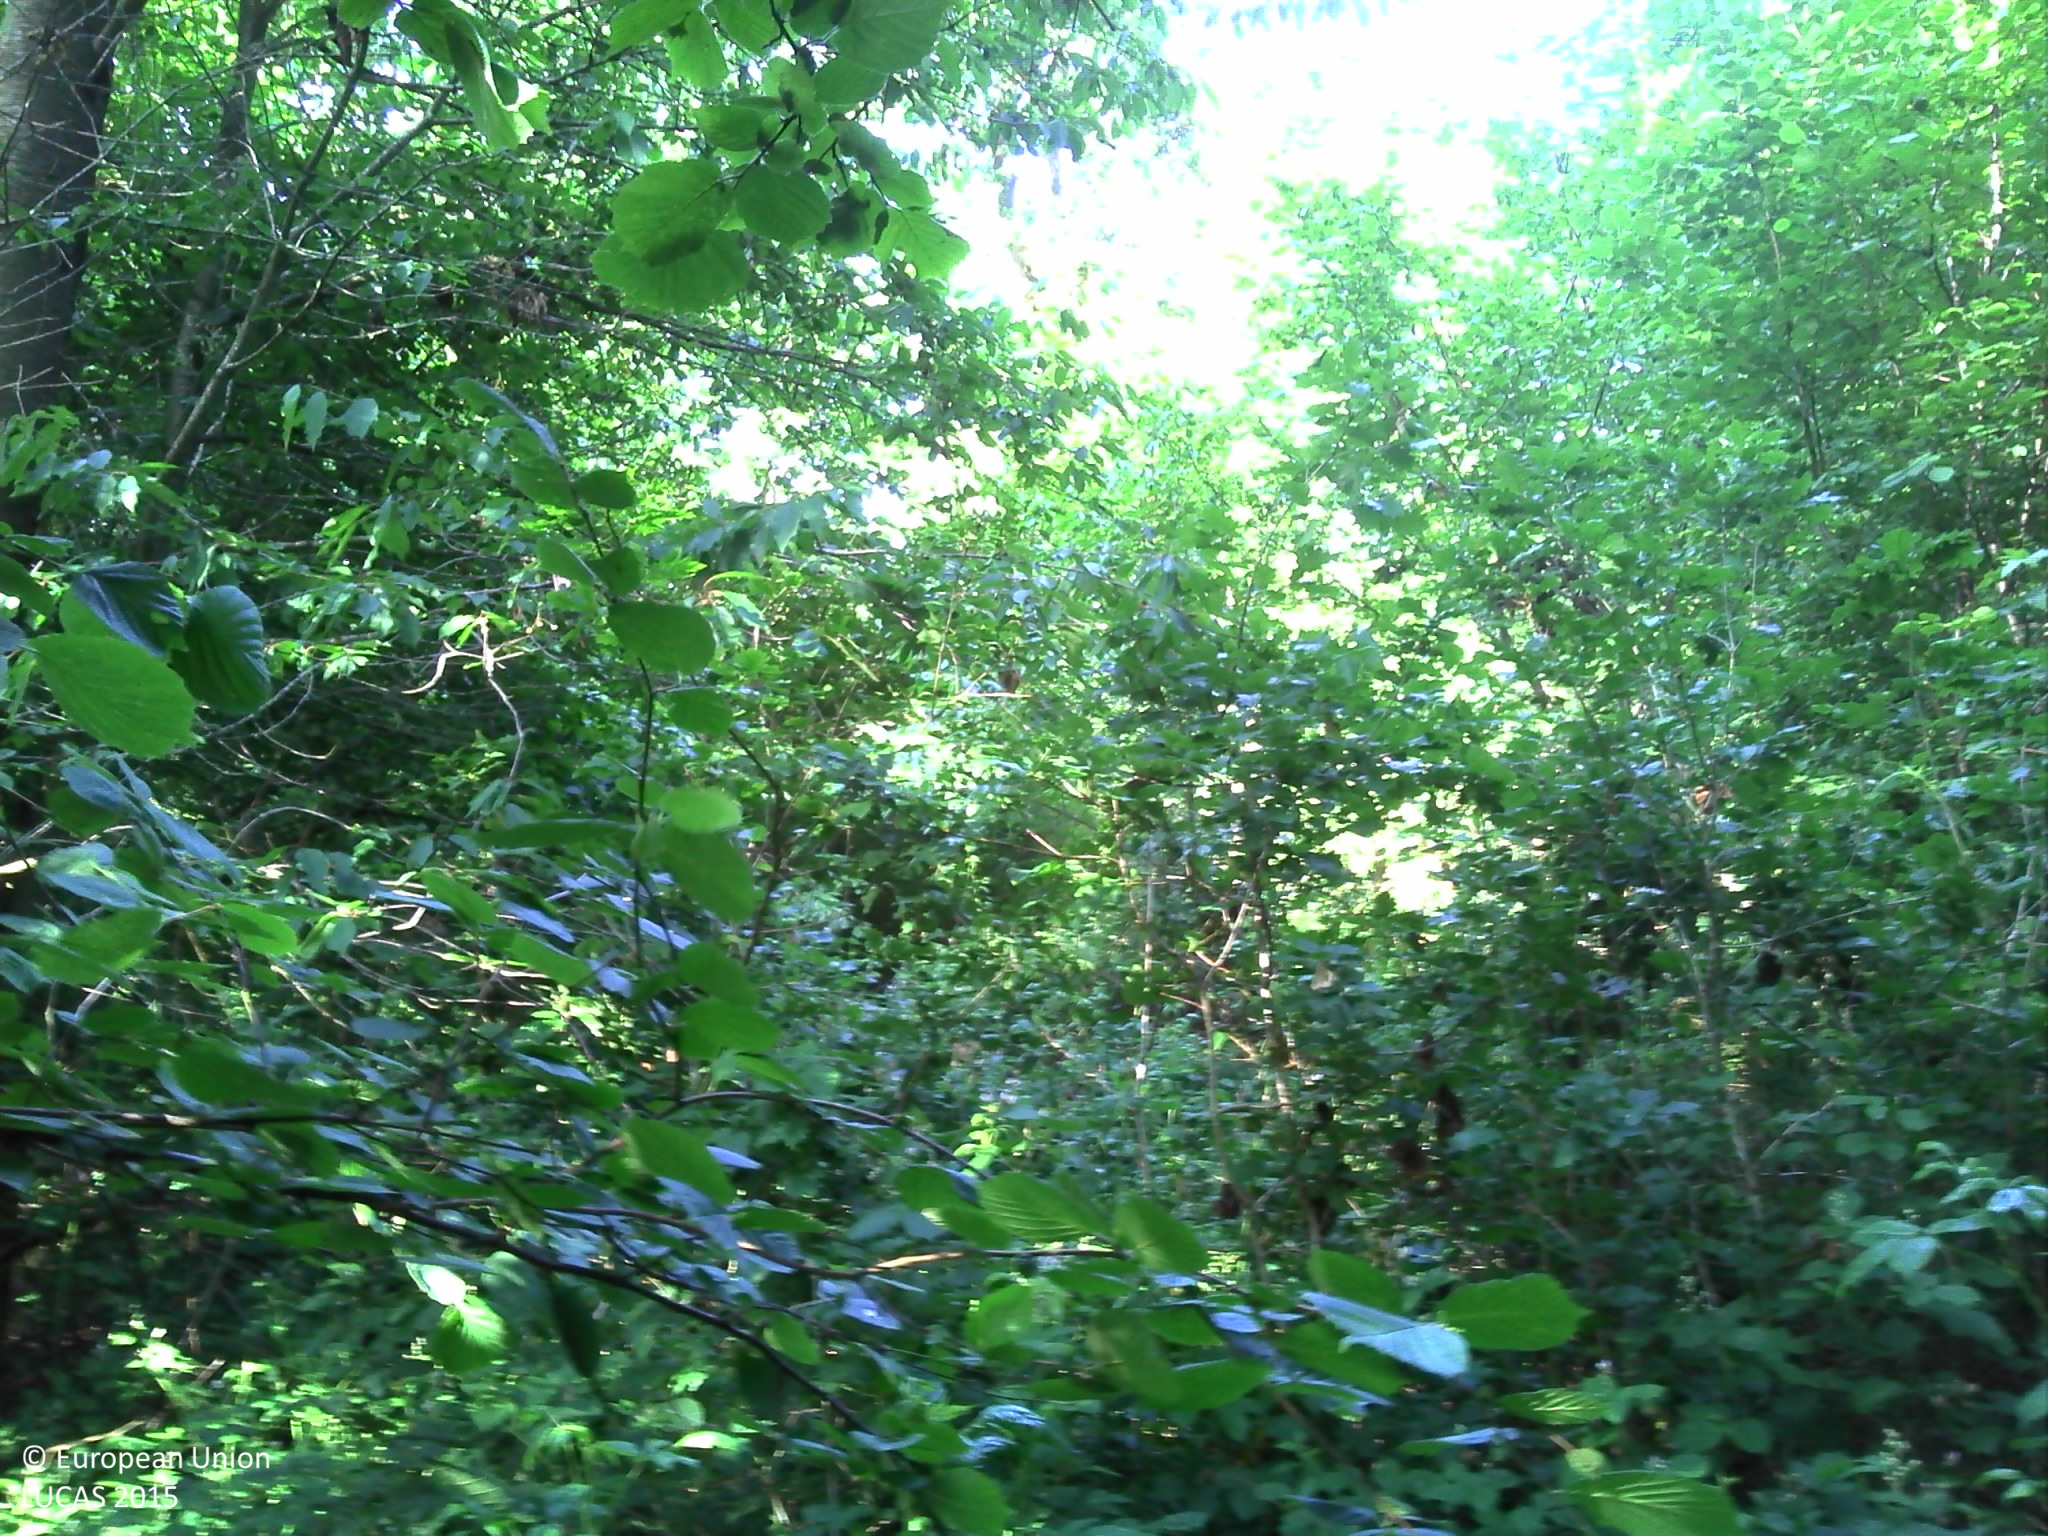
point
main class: Woodland
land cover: Broadleaved woodland
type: mesophytic deciduous forest
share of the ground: > 75 %
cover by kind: broadleaved forest trees 80 %, herbaceous plants 10 %, consolidated bare surface 10 %
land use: Forestry
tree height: > 5 m
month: June
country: FR
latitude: 49.1622
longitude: 1.0510
